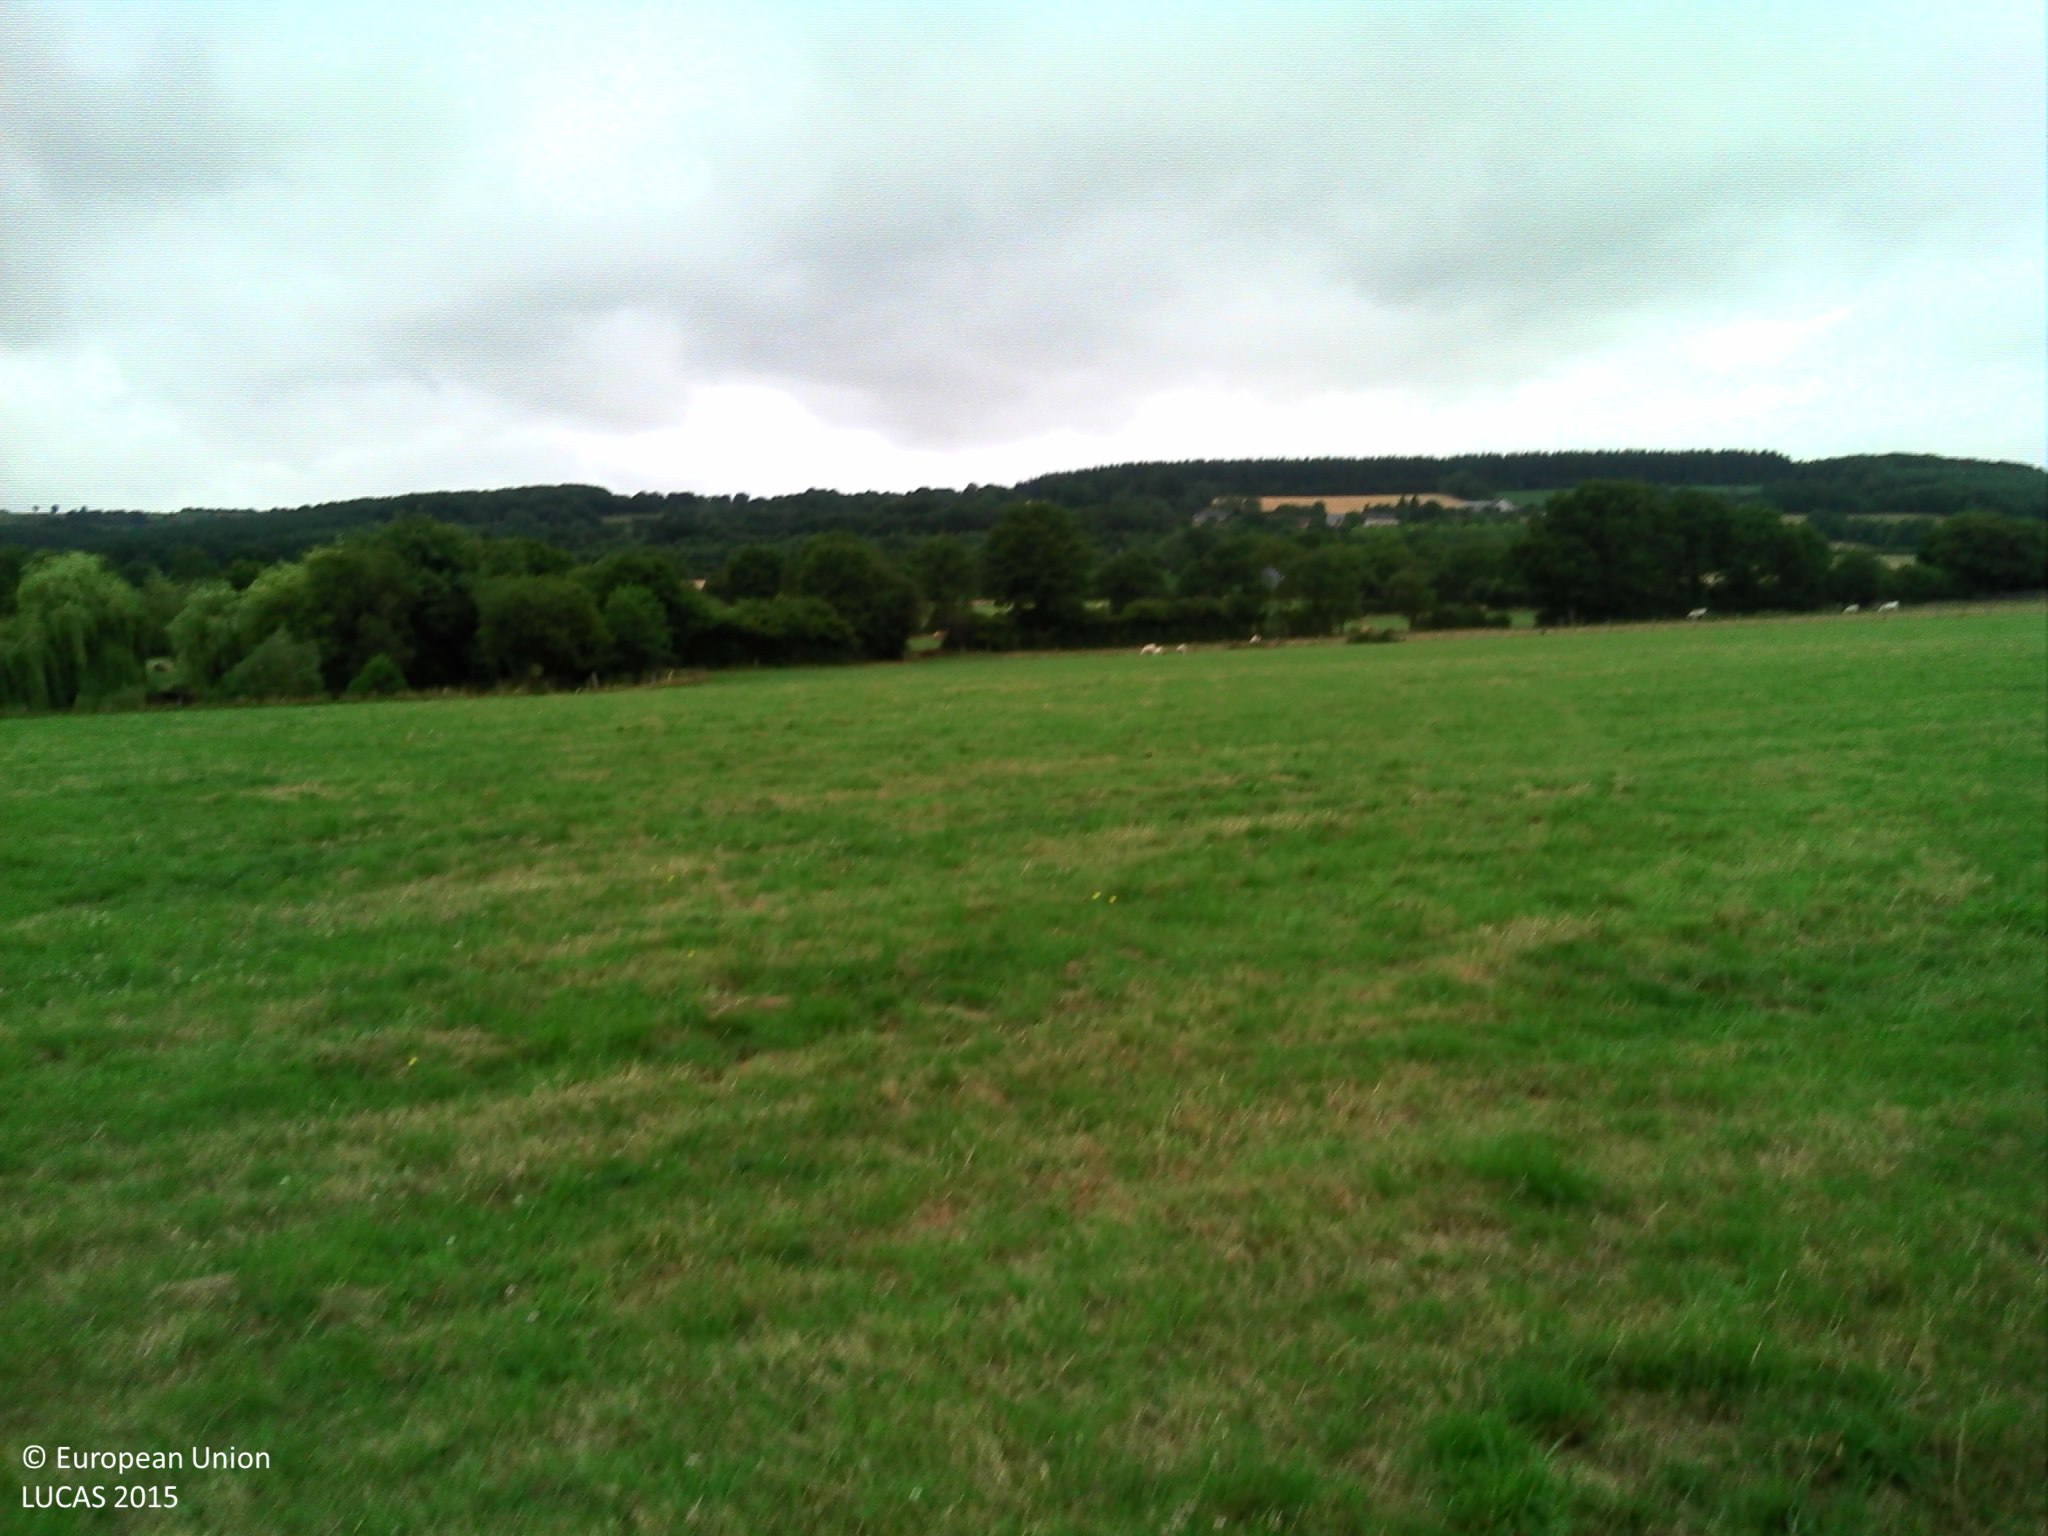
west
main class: Grassland
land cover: Grassland without tree/shrub cover
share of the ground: > 75 %
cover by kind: herbaceous plants 100 %
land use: Agriculture (excluding fallow land and kitchen gardens)
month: July
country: FR
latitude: 48.4221
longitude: -0.1794
